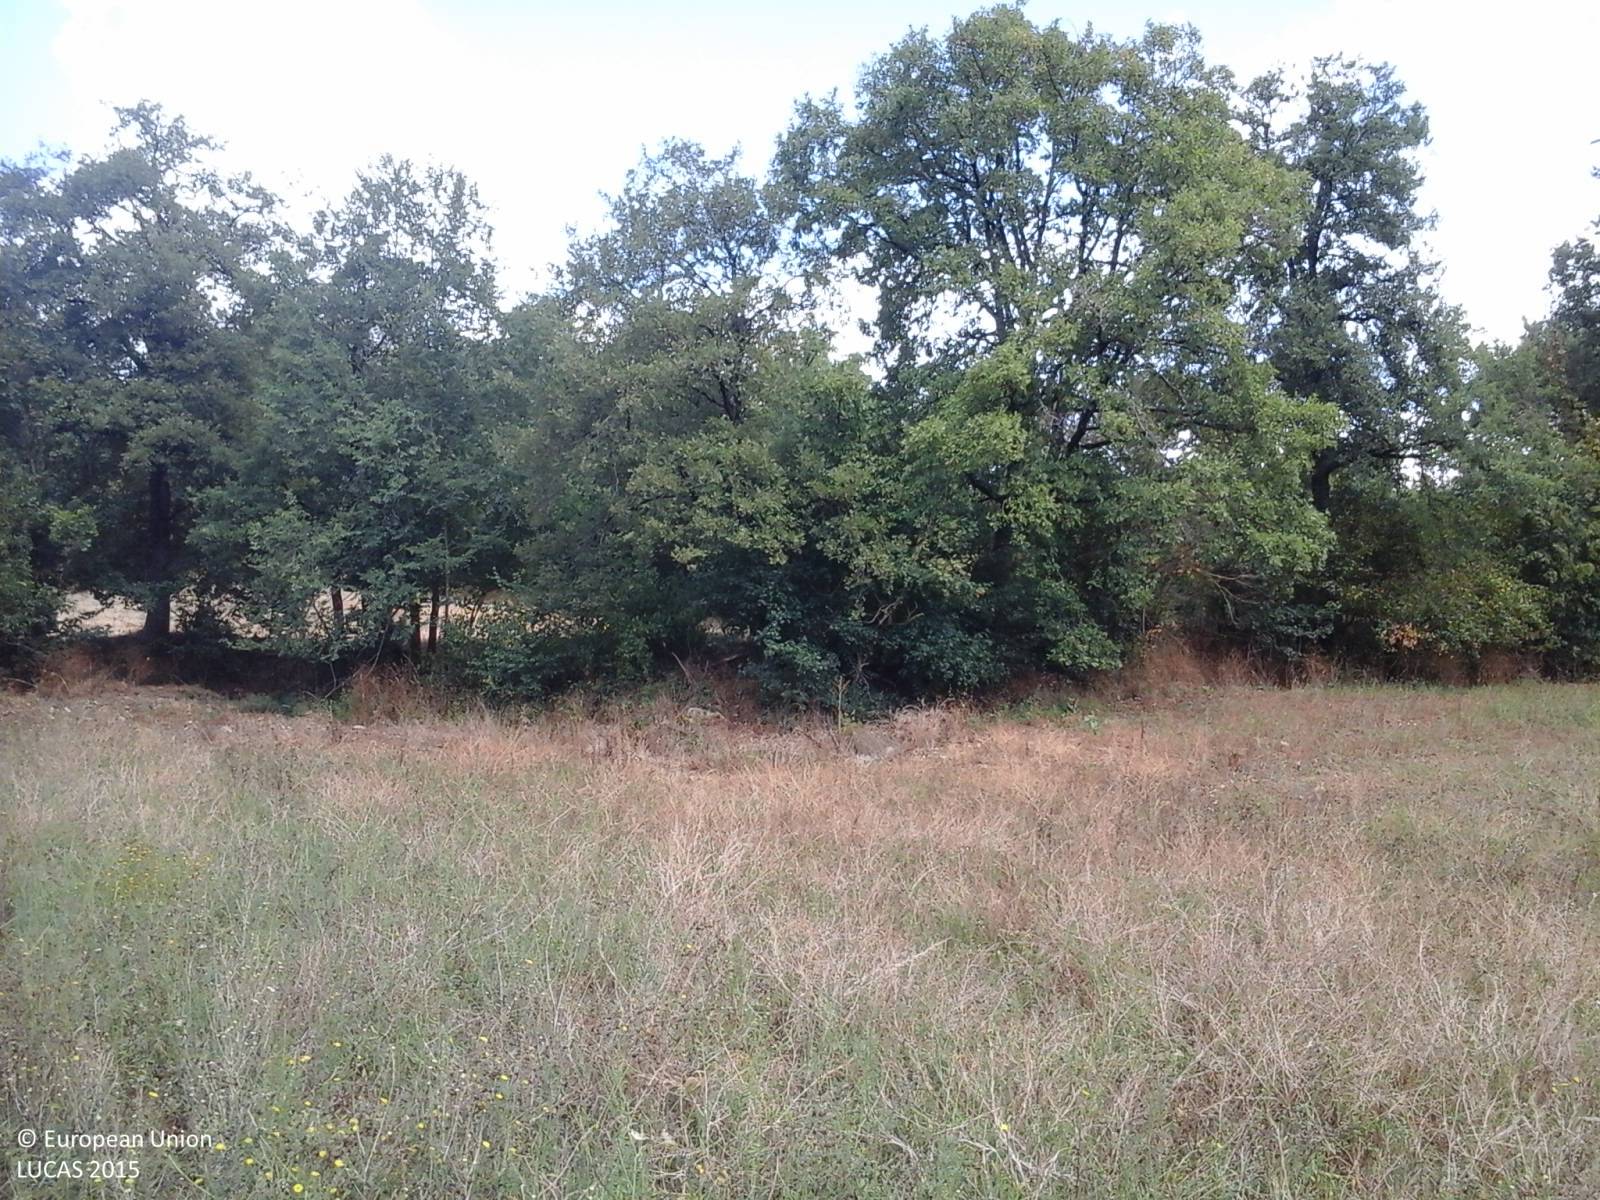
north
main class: Cropland
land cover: Temporary grasslands
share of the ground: > 75 %
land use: Agriculture (excluding fallow land and kitchen gardens)
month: August
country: IT
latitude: 43.4629
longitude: 12.1078
